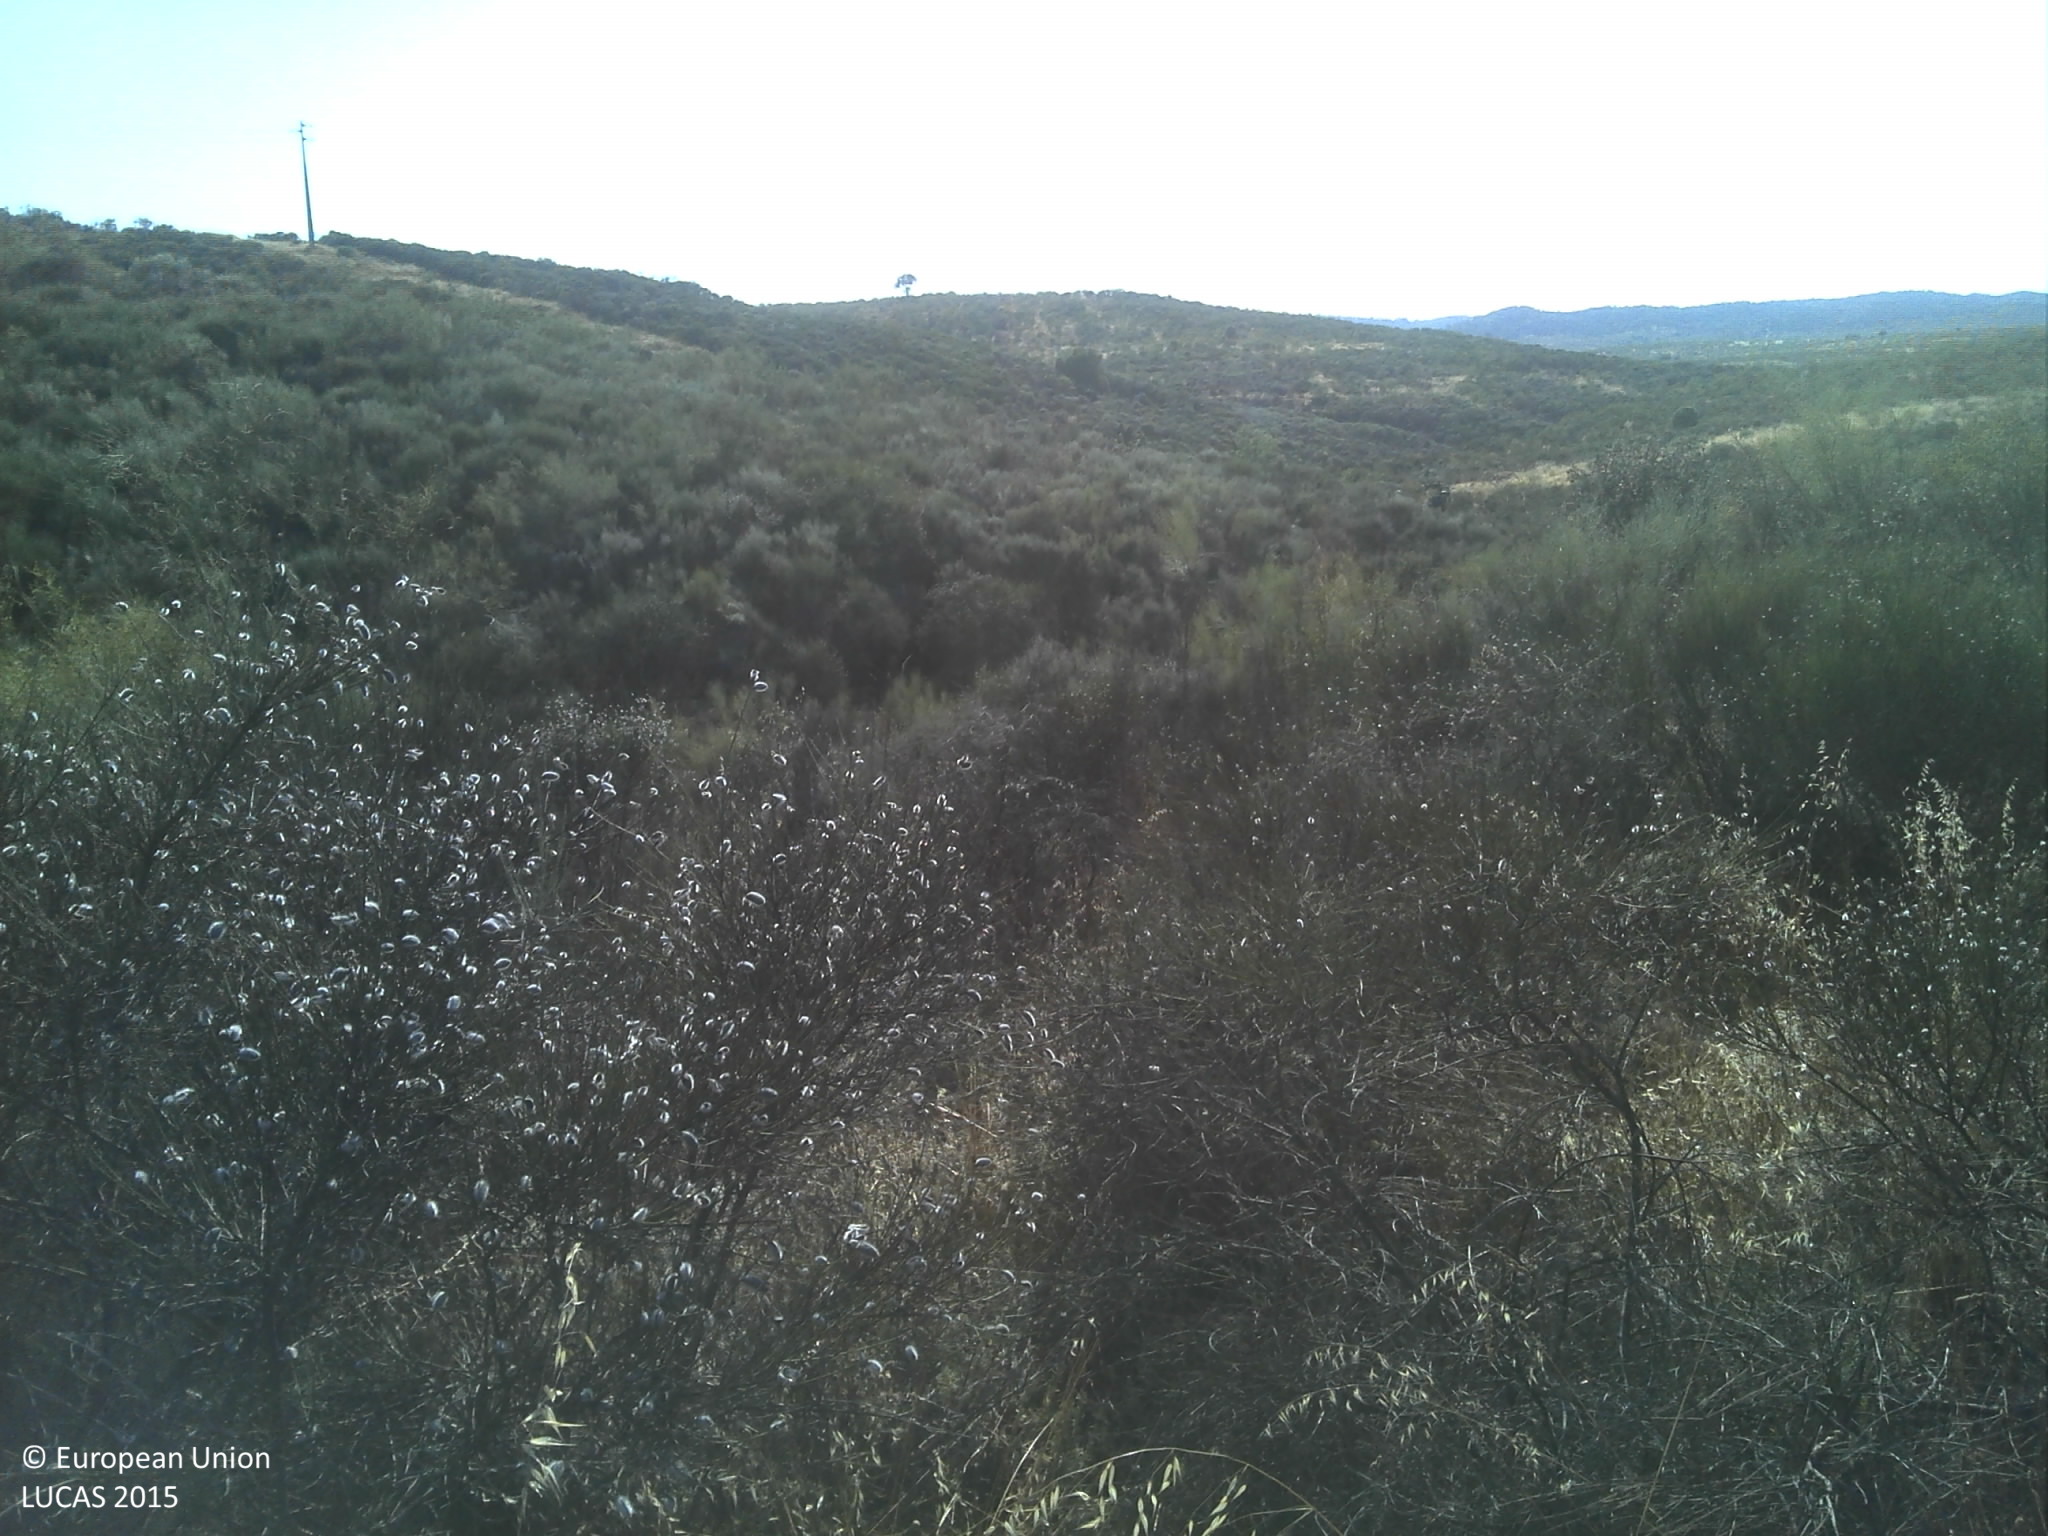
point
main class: Shrubland
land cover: Shrubland without tree cover
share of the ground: 50 - 75 %
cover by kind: shrubs 70 %, herbaceous plants 15 %, unconsolidated bare surface 10 %
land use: Abandoned areas
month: June
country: PT
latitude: 39.8021
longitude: -7.0111
